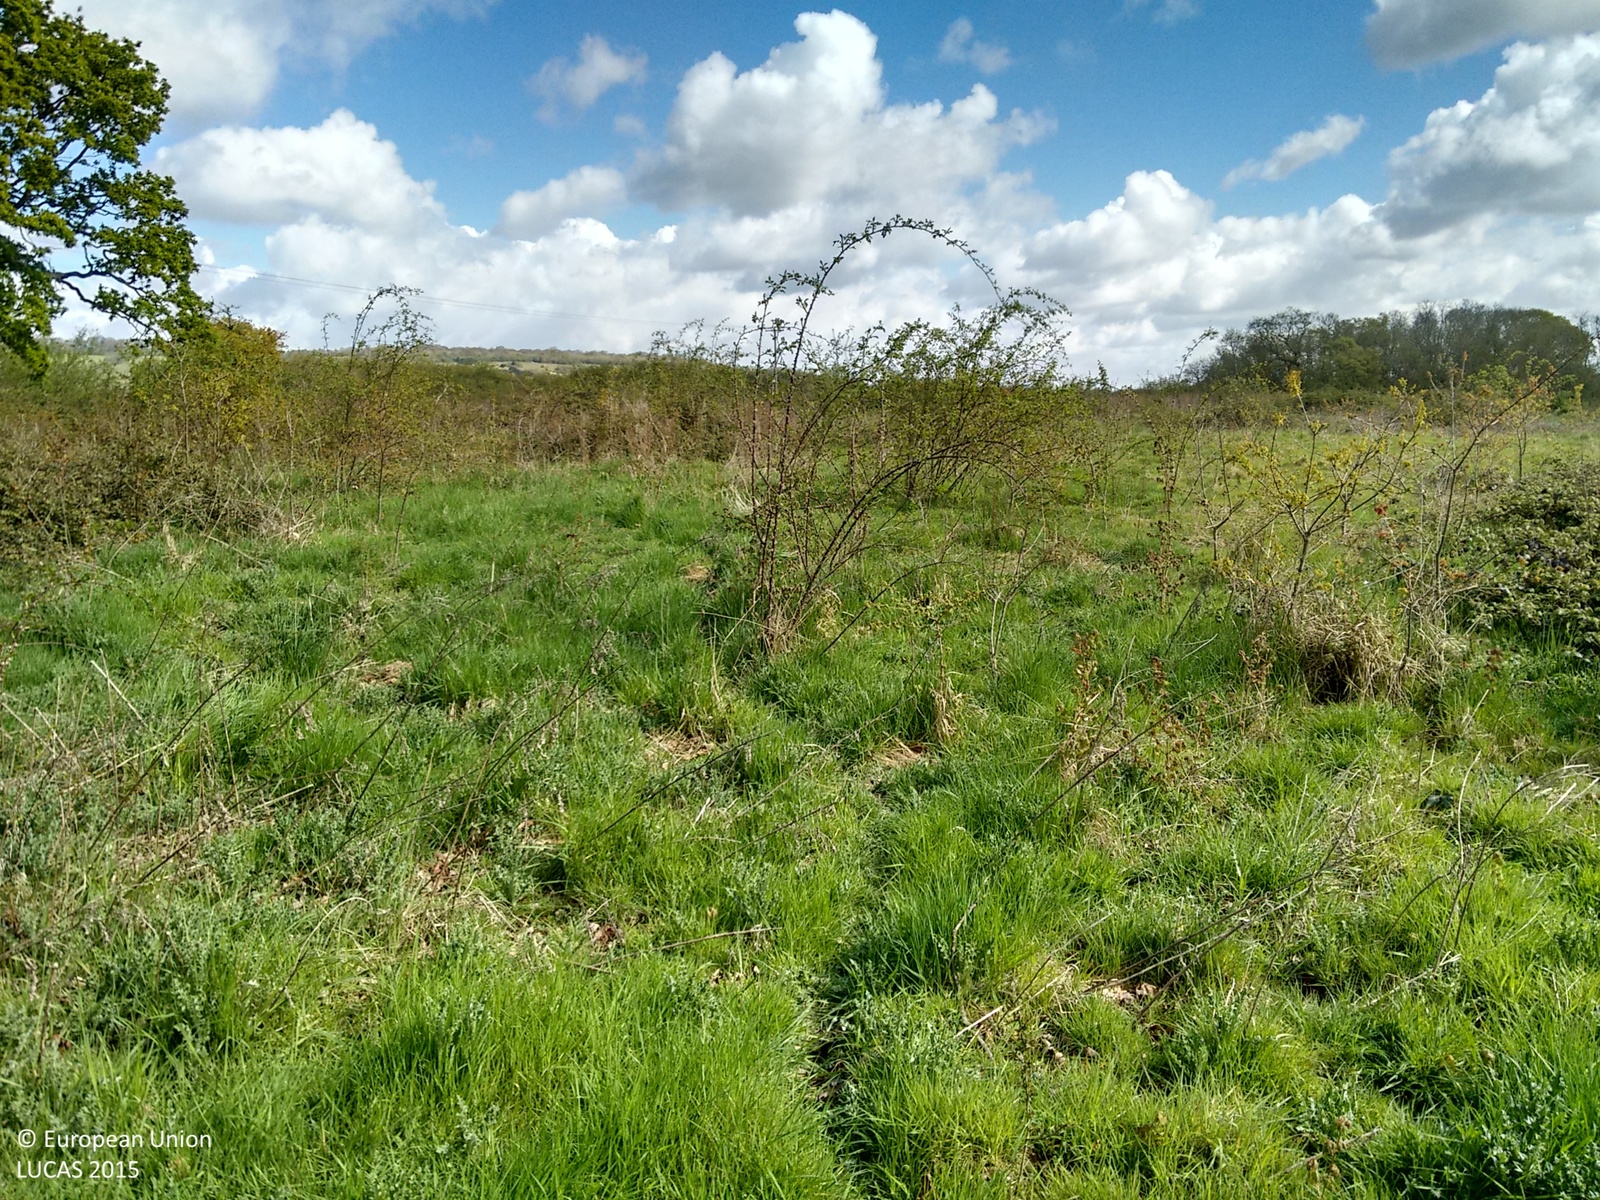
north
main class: Grassland
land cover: Grassland with sparse tree/shrub cover
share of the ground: > 75 %
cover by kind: herbaceous plants 85 %, shrubs 10 %, broadleaved forest trees 5 %
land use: Abandoned areas
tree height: < 5 m
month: April
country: GB
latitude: 51.3177
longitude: 0.4010
